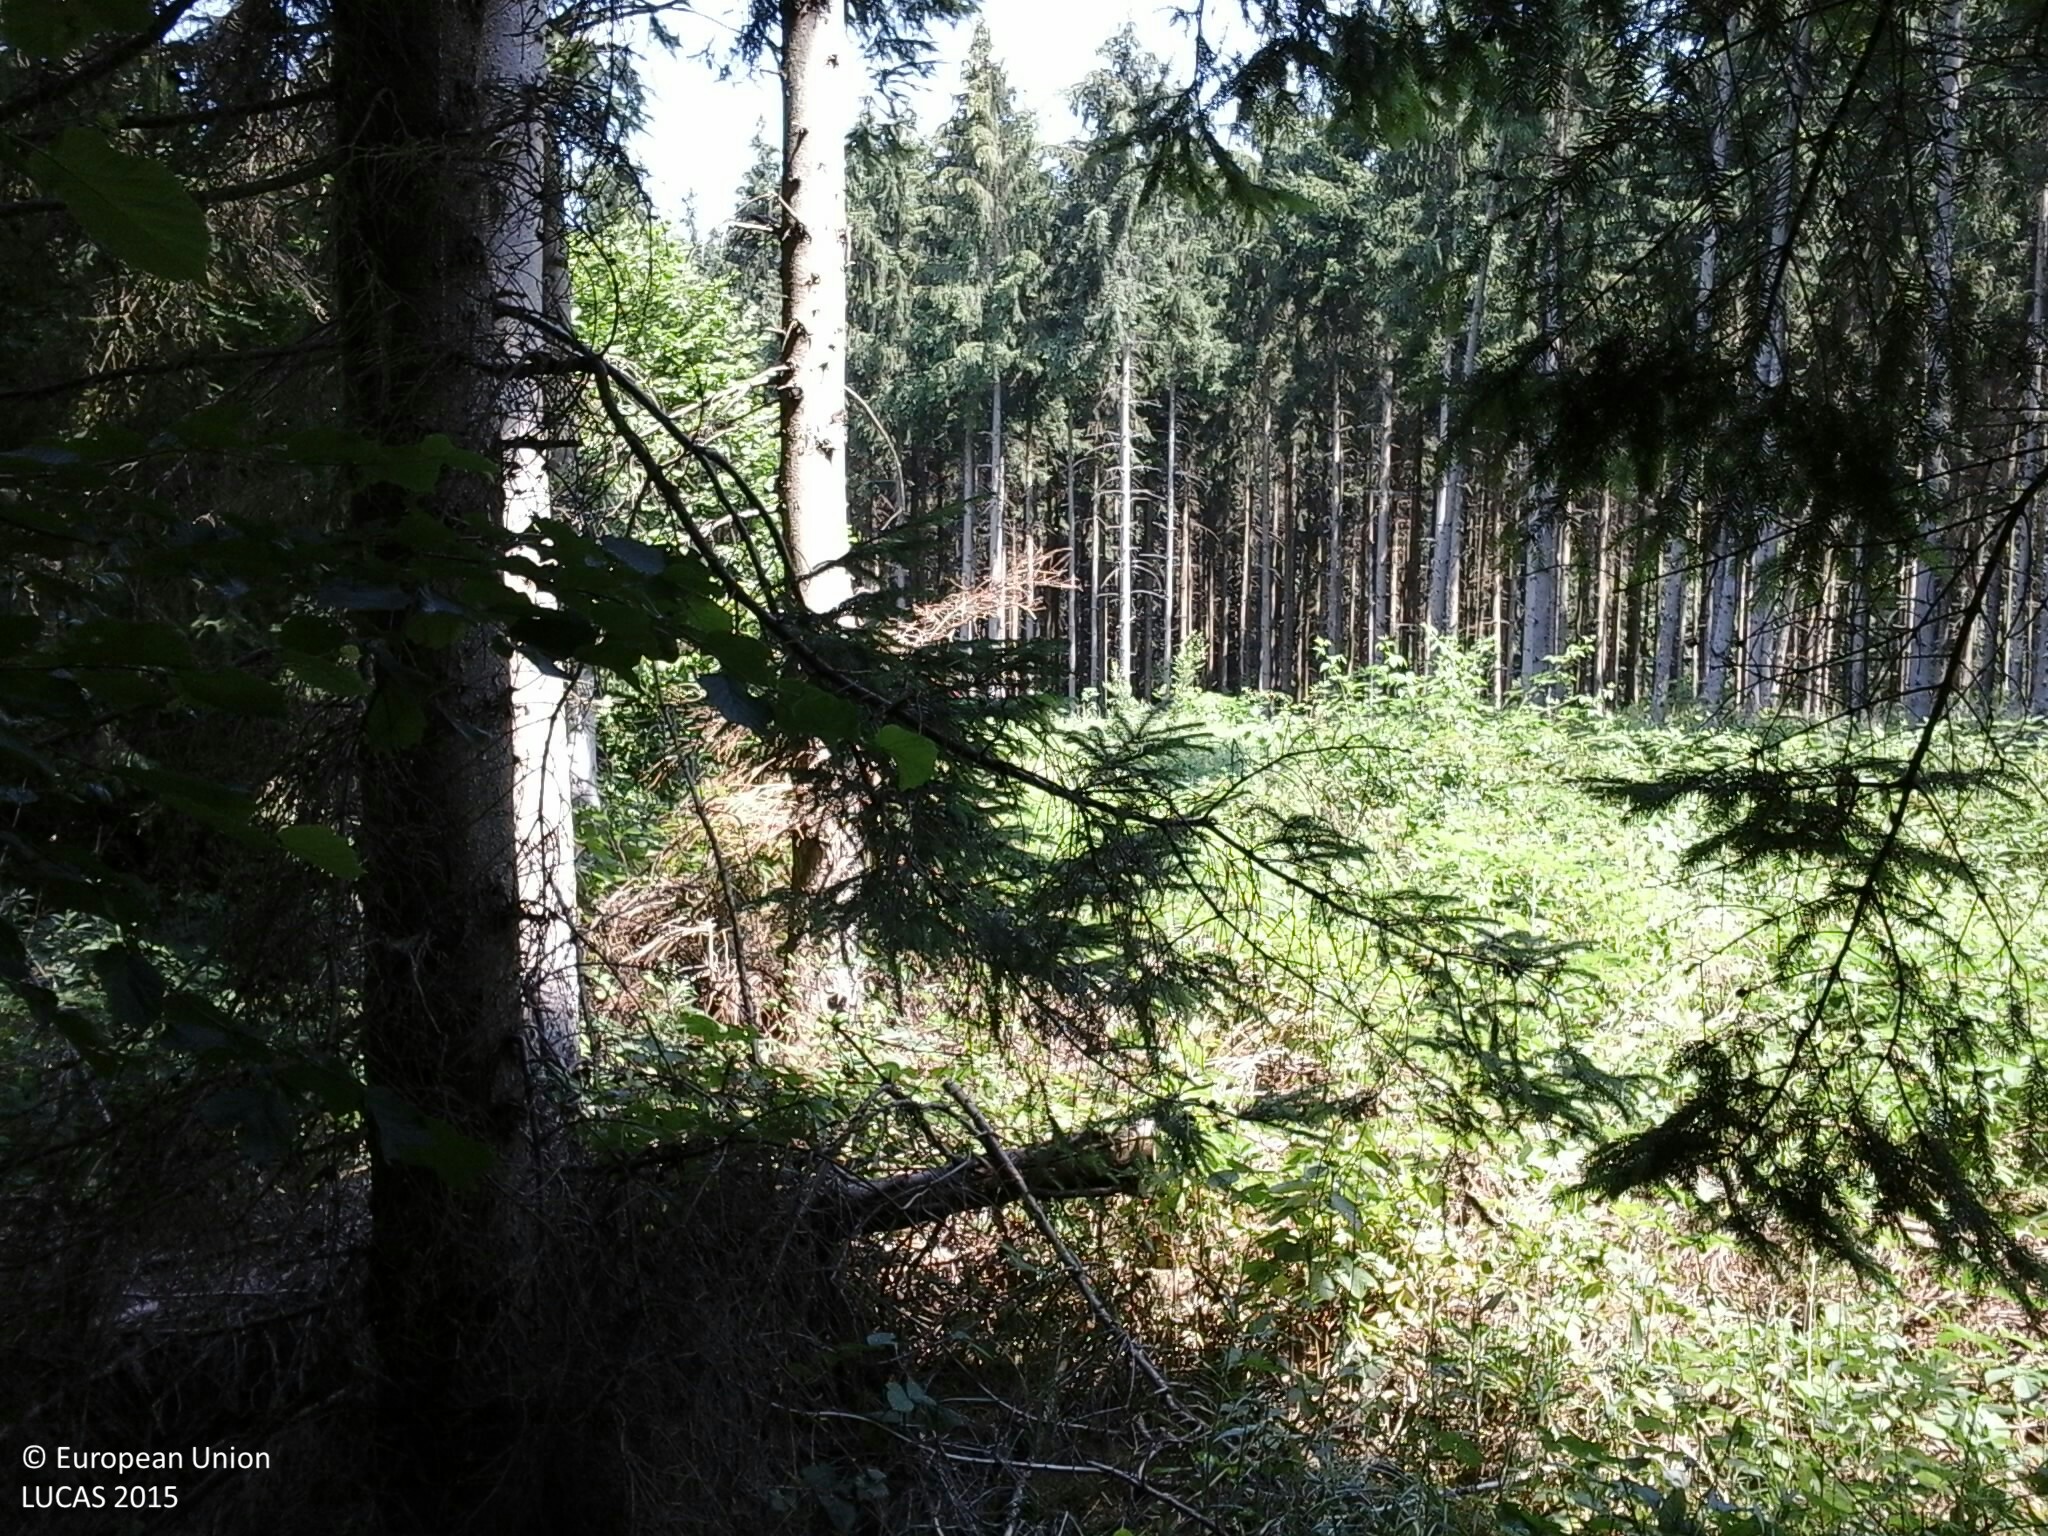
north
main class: Woodland
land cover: Pine dominated coniferous woodland
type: hemiboreal forest and nemoral coniferous forest and mixed broadleaved-coniferous forest
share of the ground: > 75 %
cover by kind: coniferous forest trees 70 %, broadleaved forest trees 20 %, shrubs 10 %
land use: Forestry
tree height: > 5 m
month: July
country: HU
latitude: 46.9424
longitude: 16.2944
